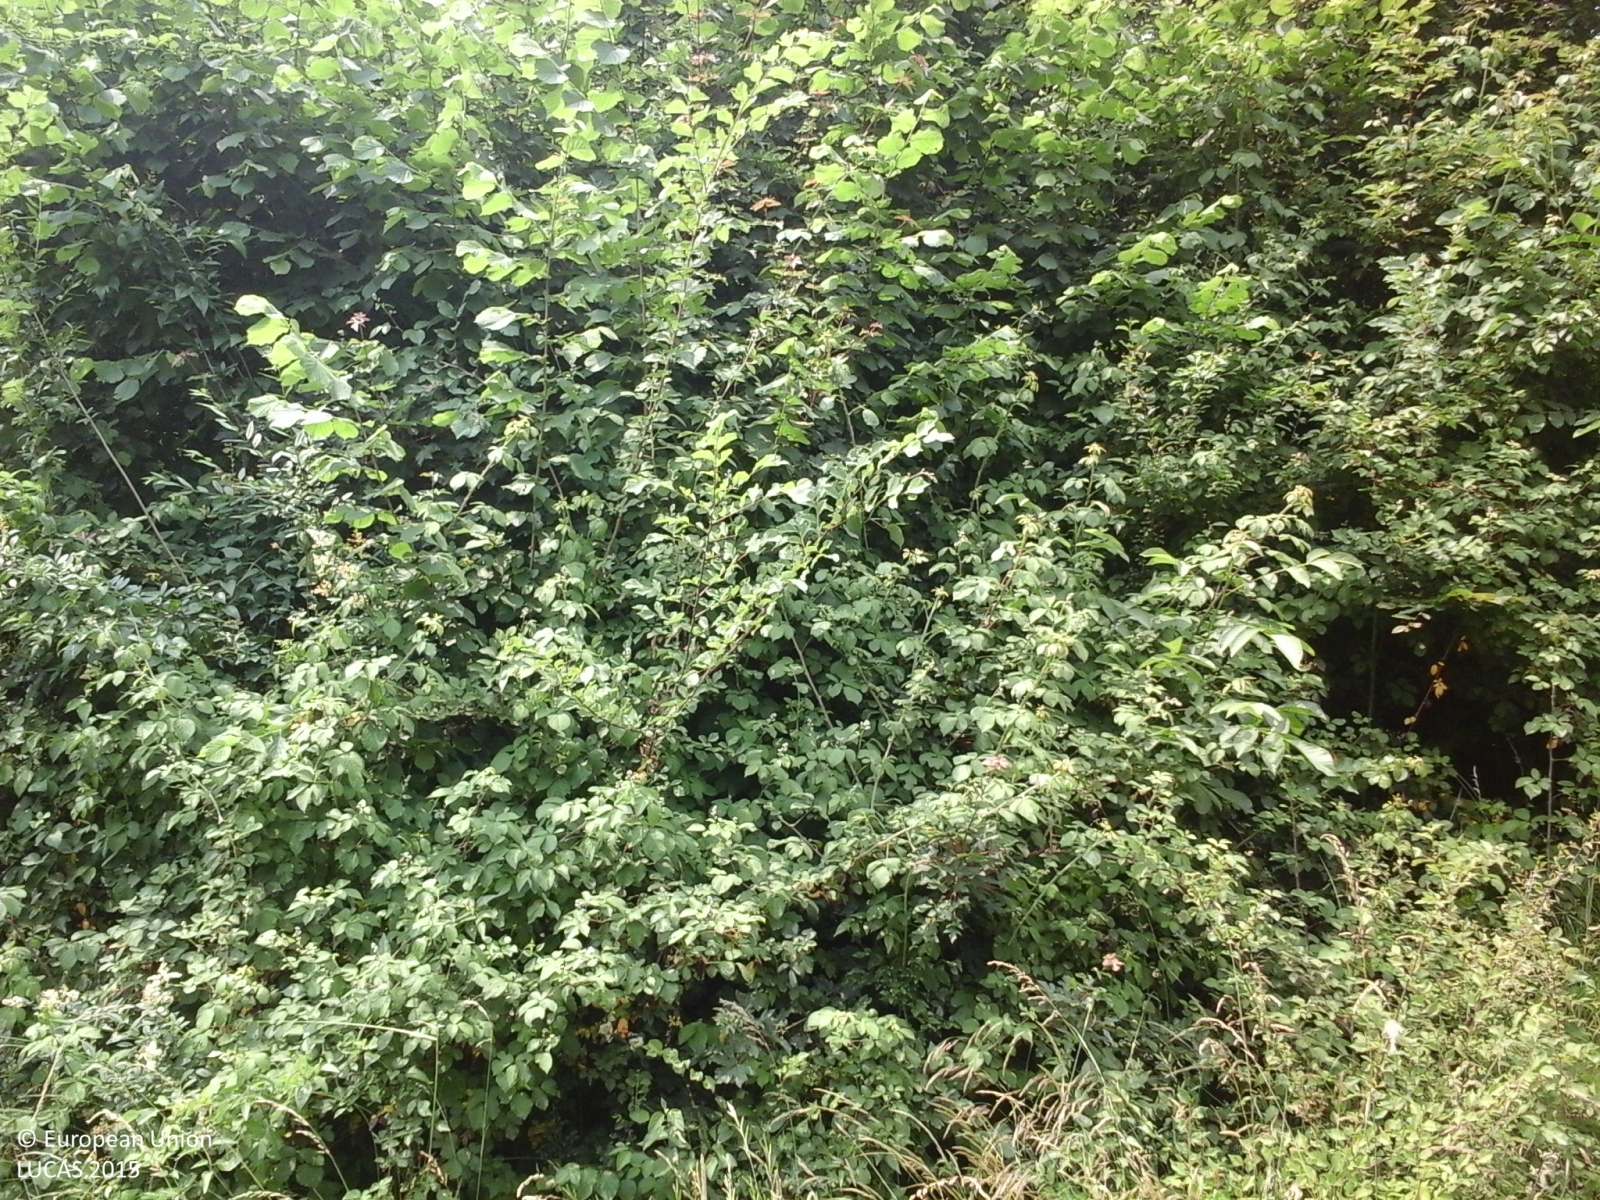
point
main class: Woodland
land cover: Broadleaved woodland
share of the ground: > 75 %
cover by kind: broadleaved forest trees 100 %
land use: Forestry
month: June
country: IT
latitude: 45.6654
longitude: 10.4998
